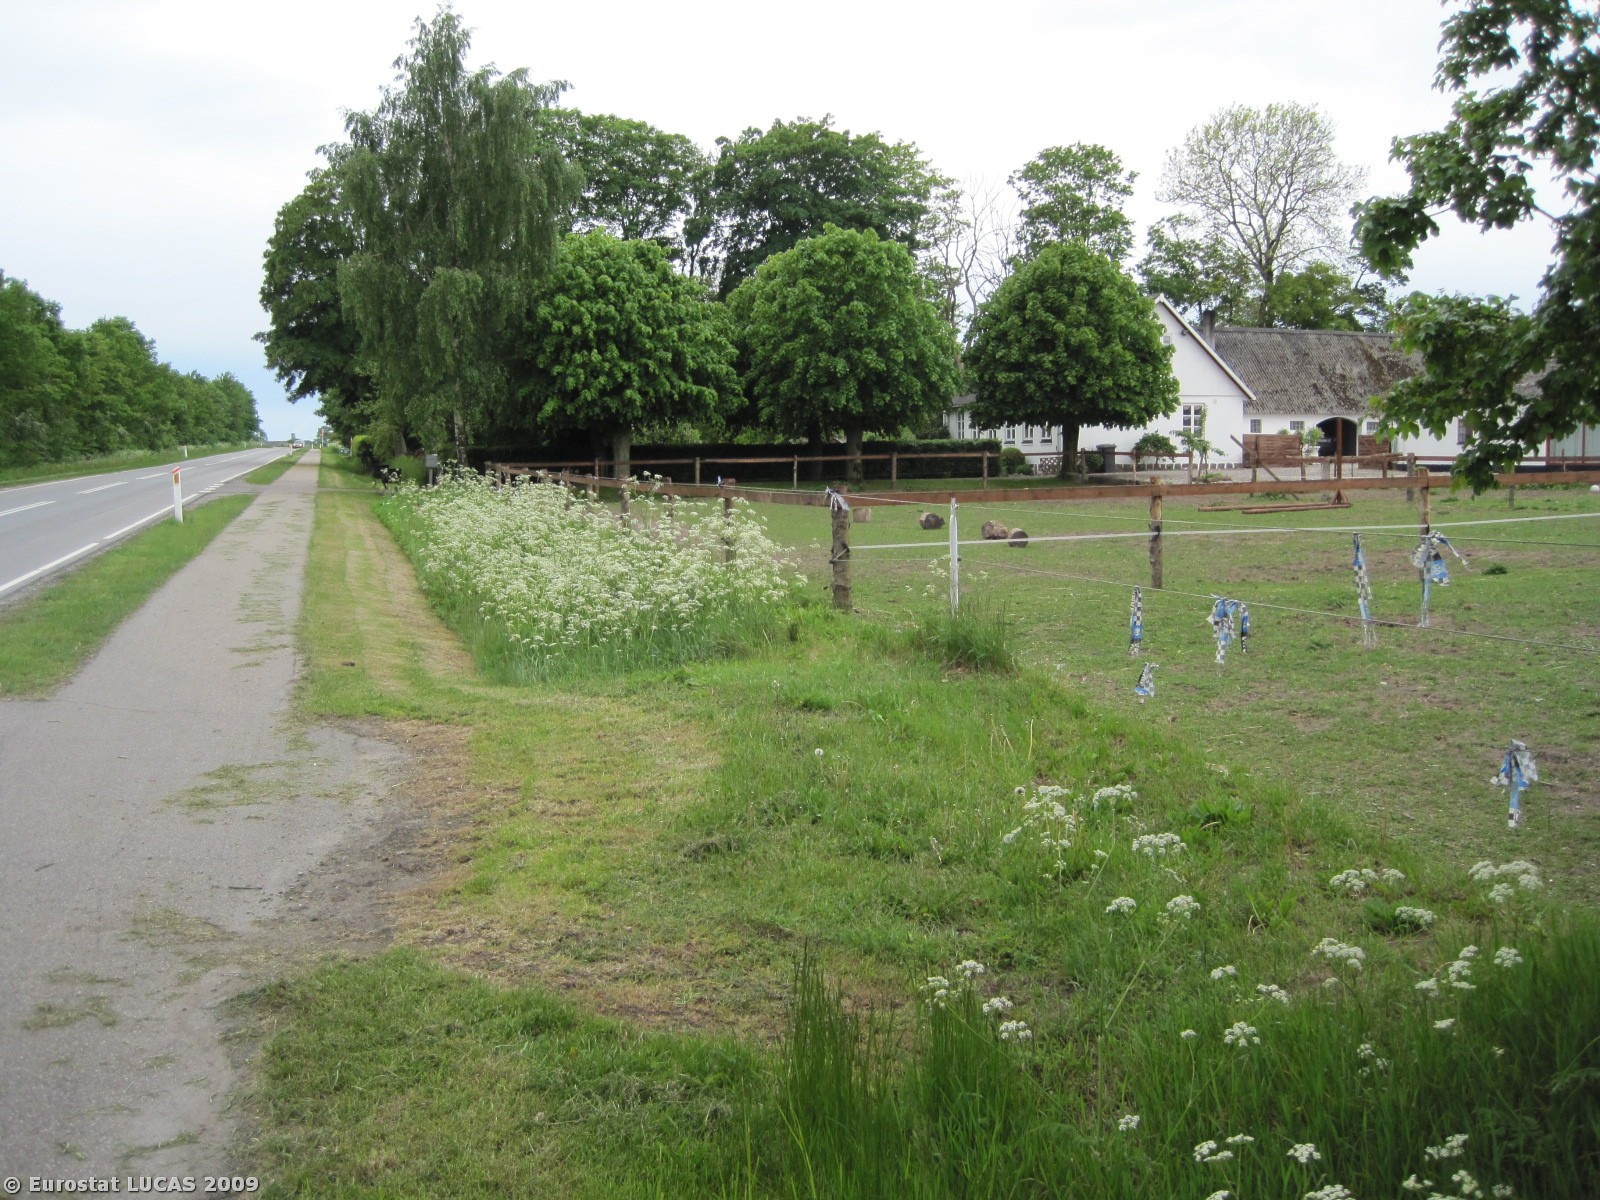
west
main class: Woodland
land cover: Broadleaved woodland
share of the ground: > 75 %
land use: Residential
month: May
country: DK
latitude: 56.7090
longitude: 10.0816
